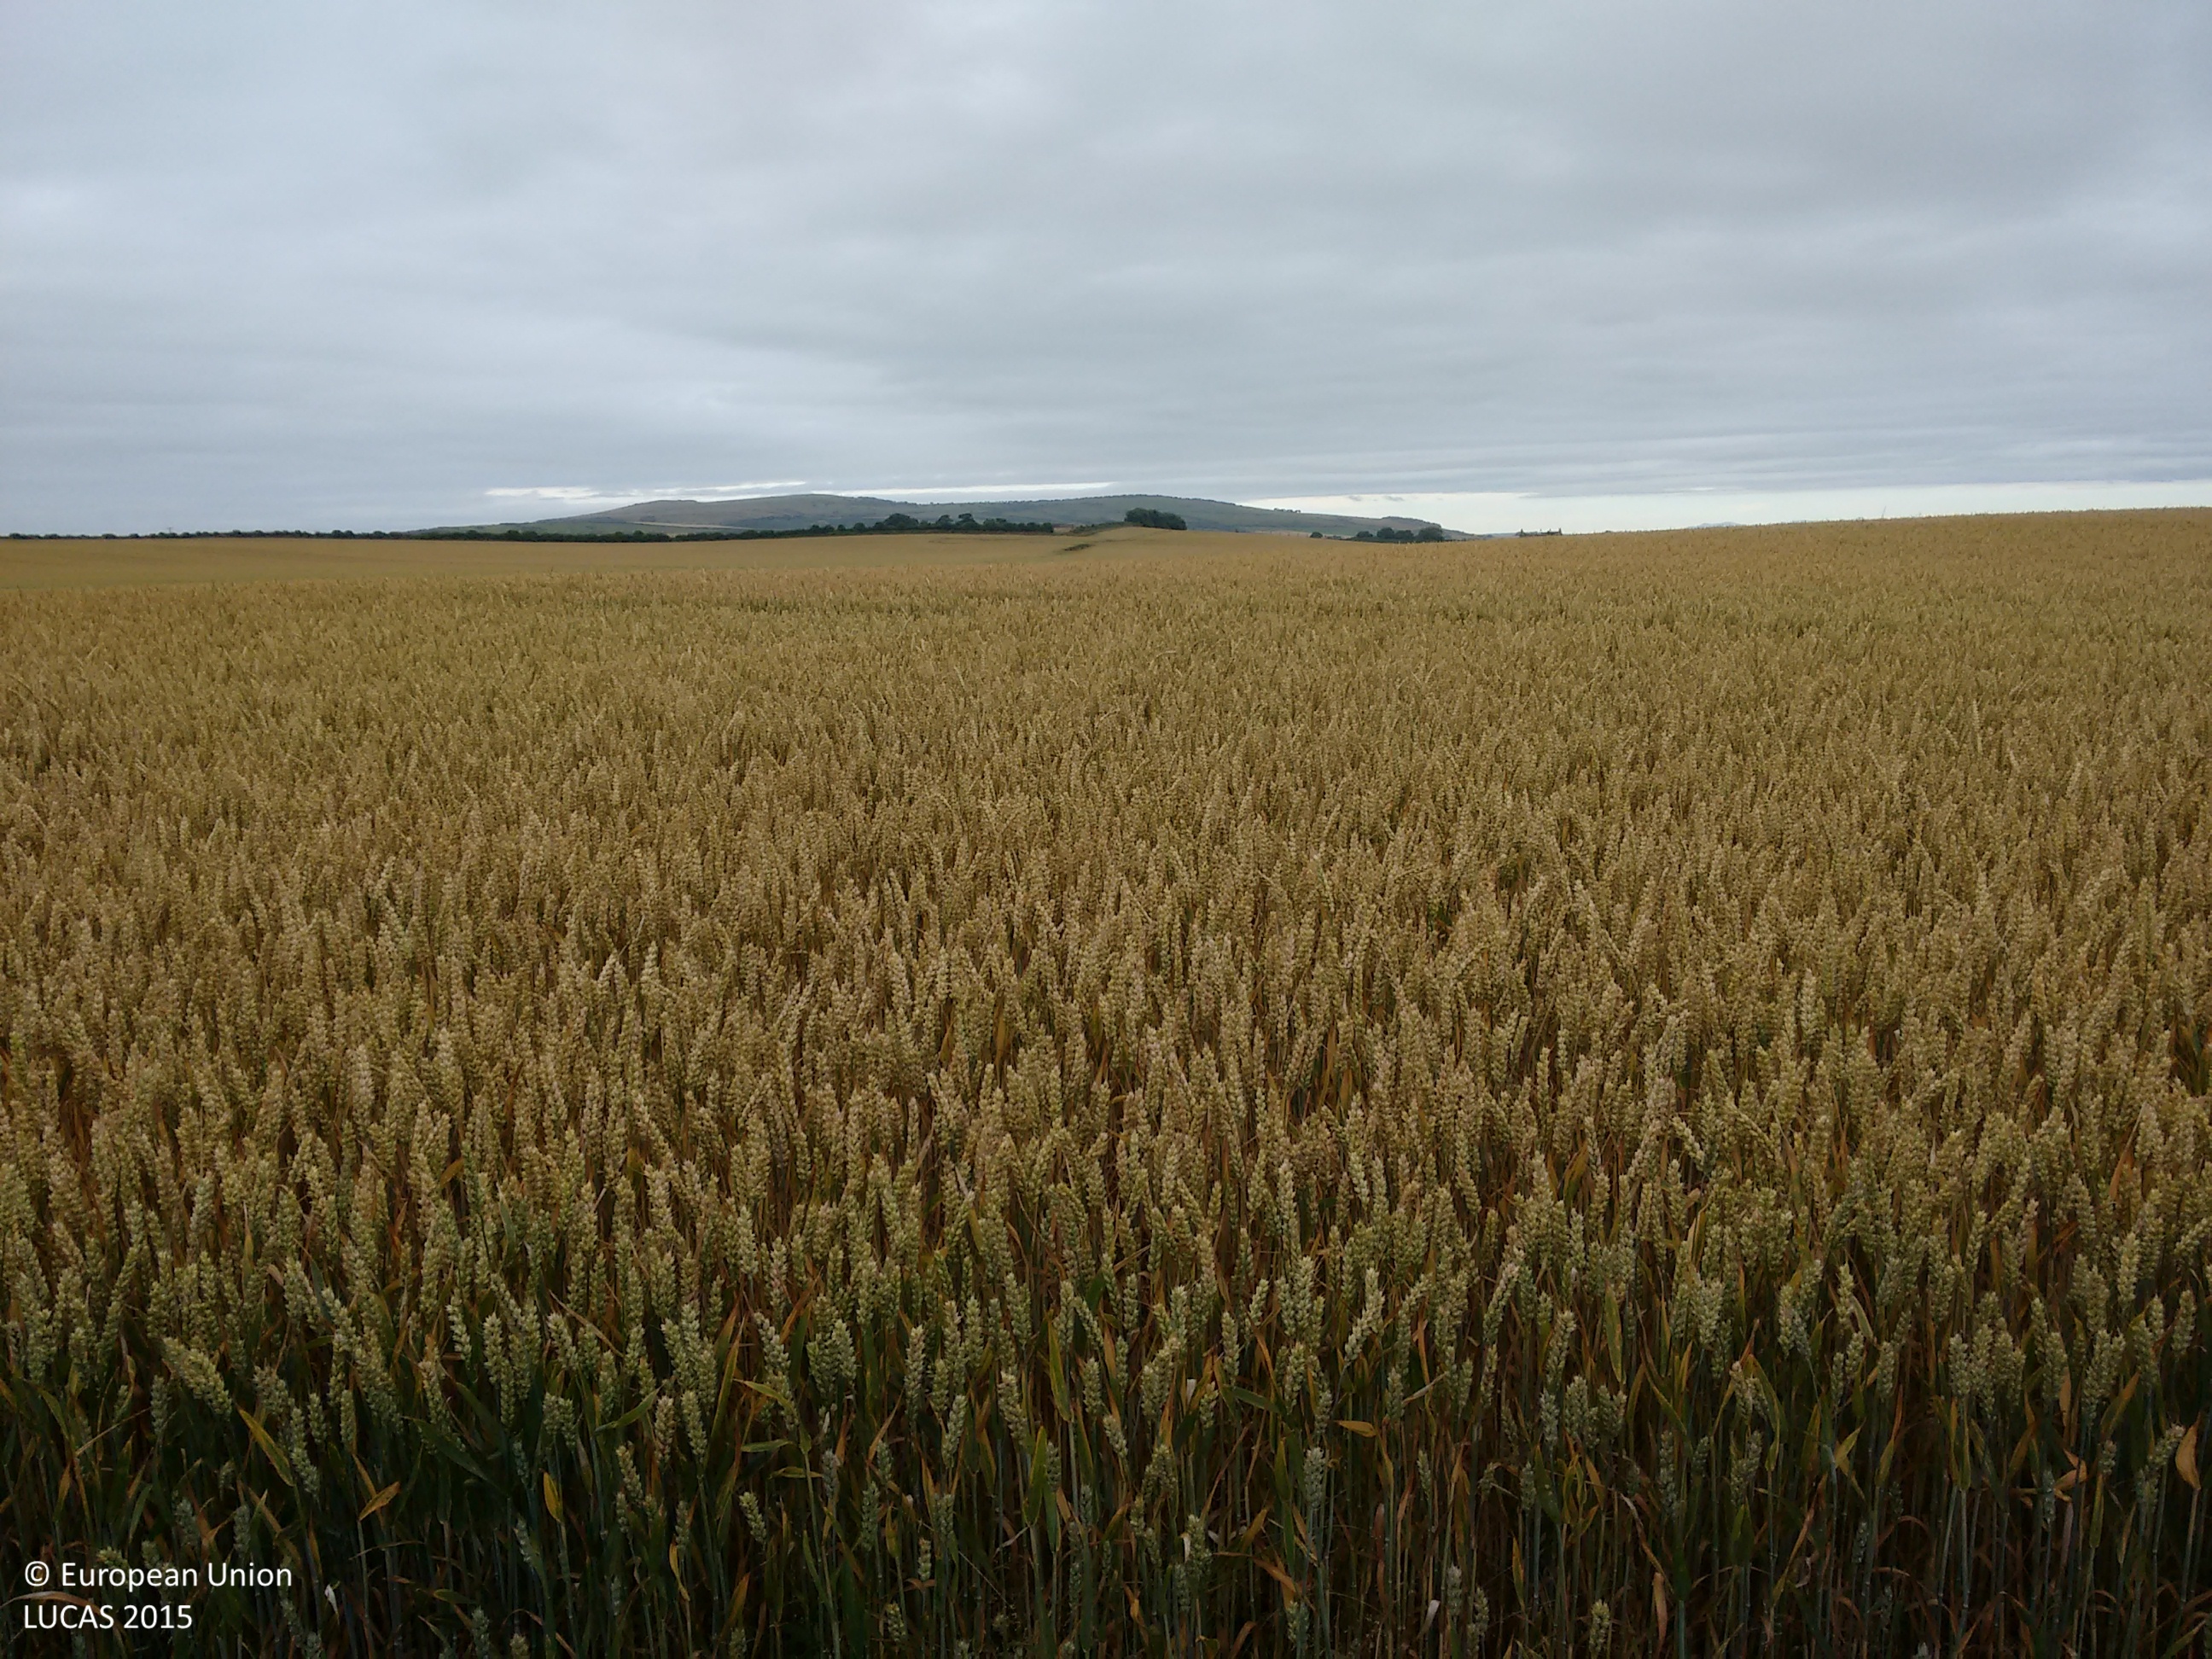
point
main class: Cropland
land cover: Common wheat
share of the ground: > 75 %
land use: Agriculture (excluding fallow land and kitchen gardens)
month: August
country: GB
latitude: 57.7655
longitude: -3.9112
